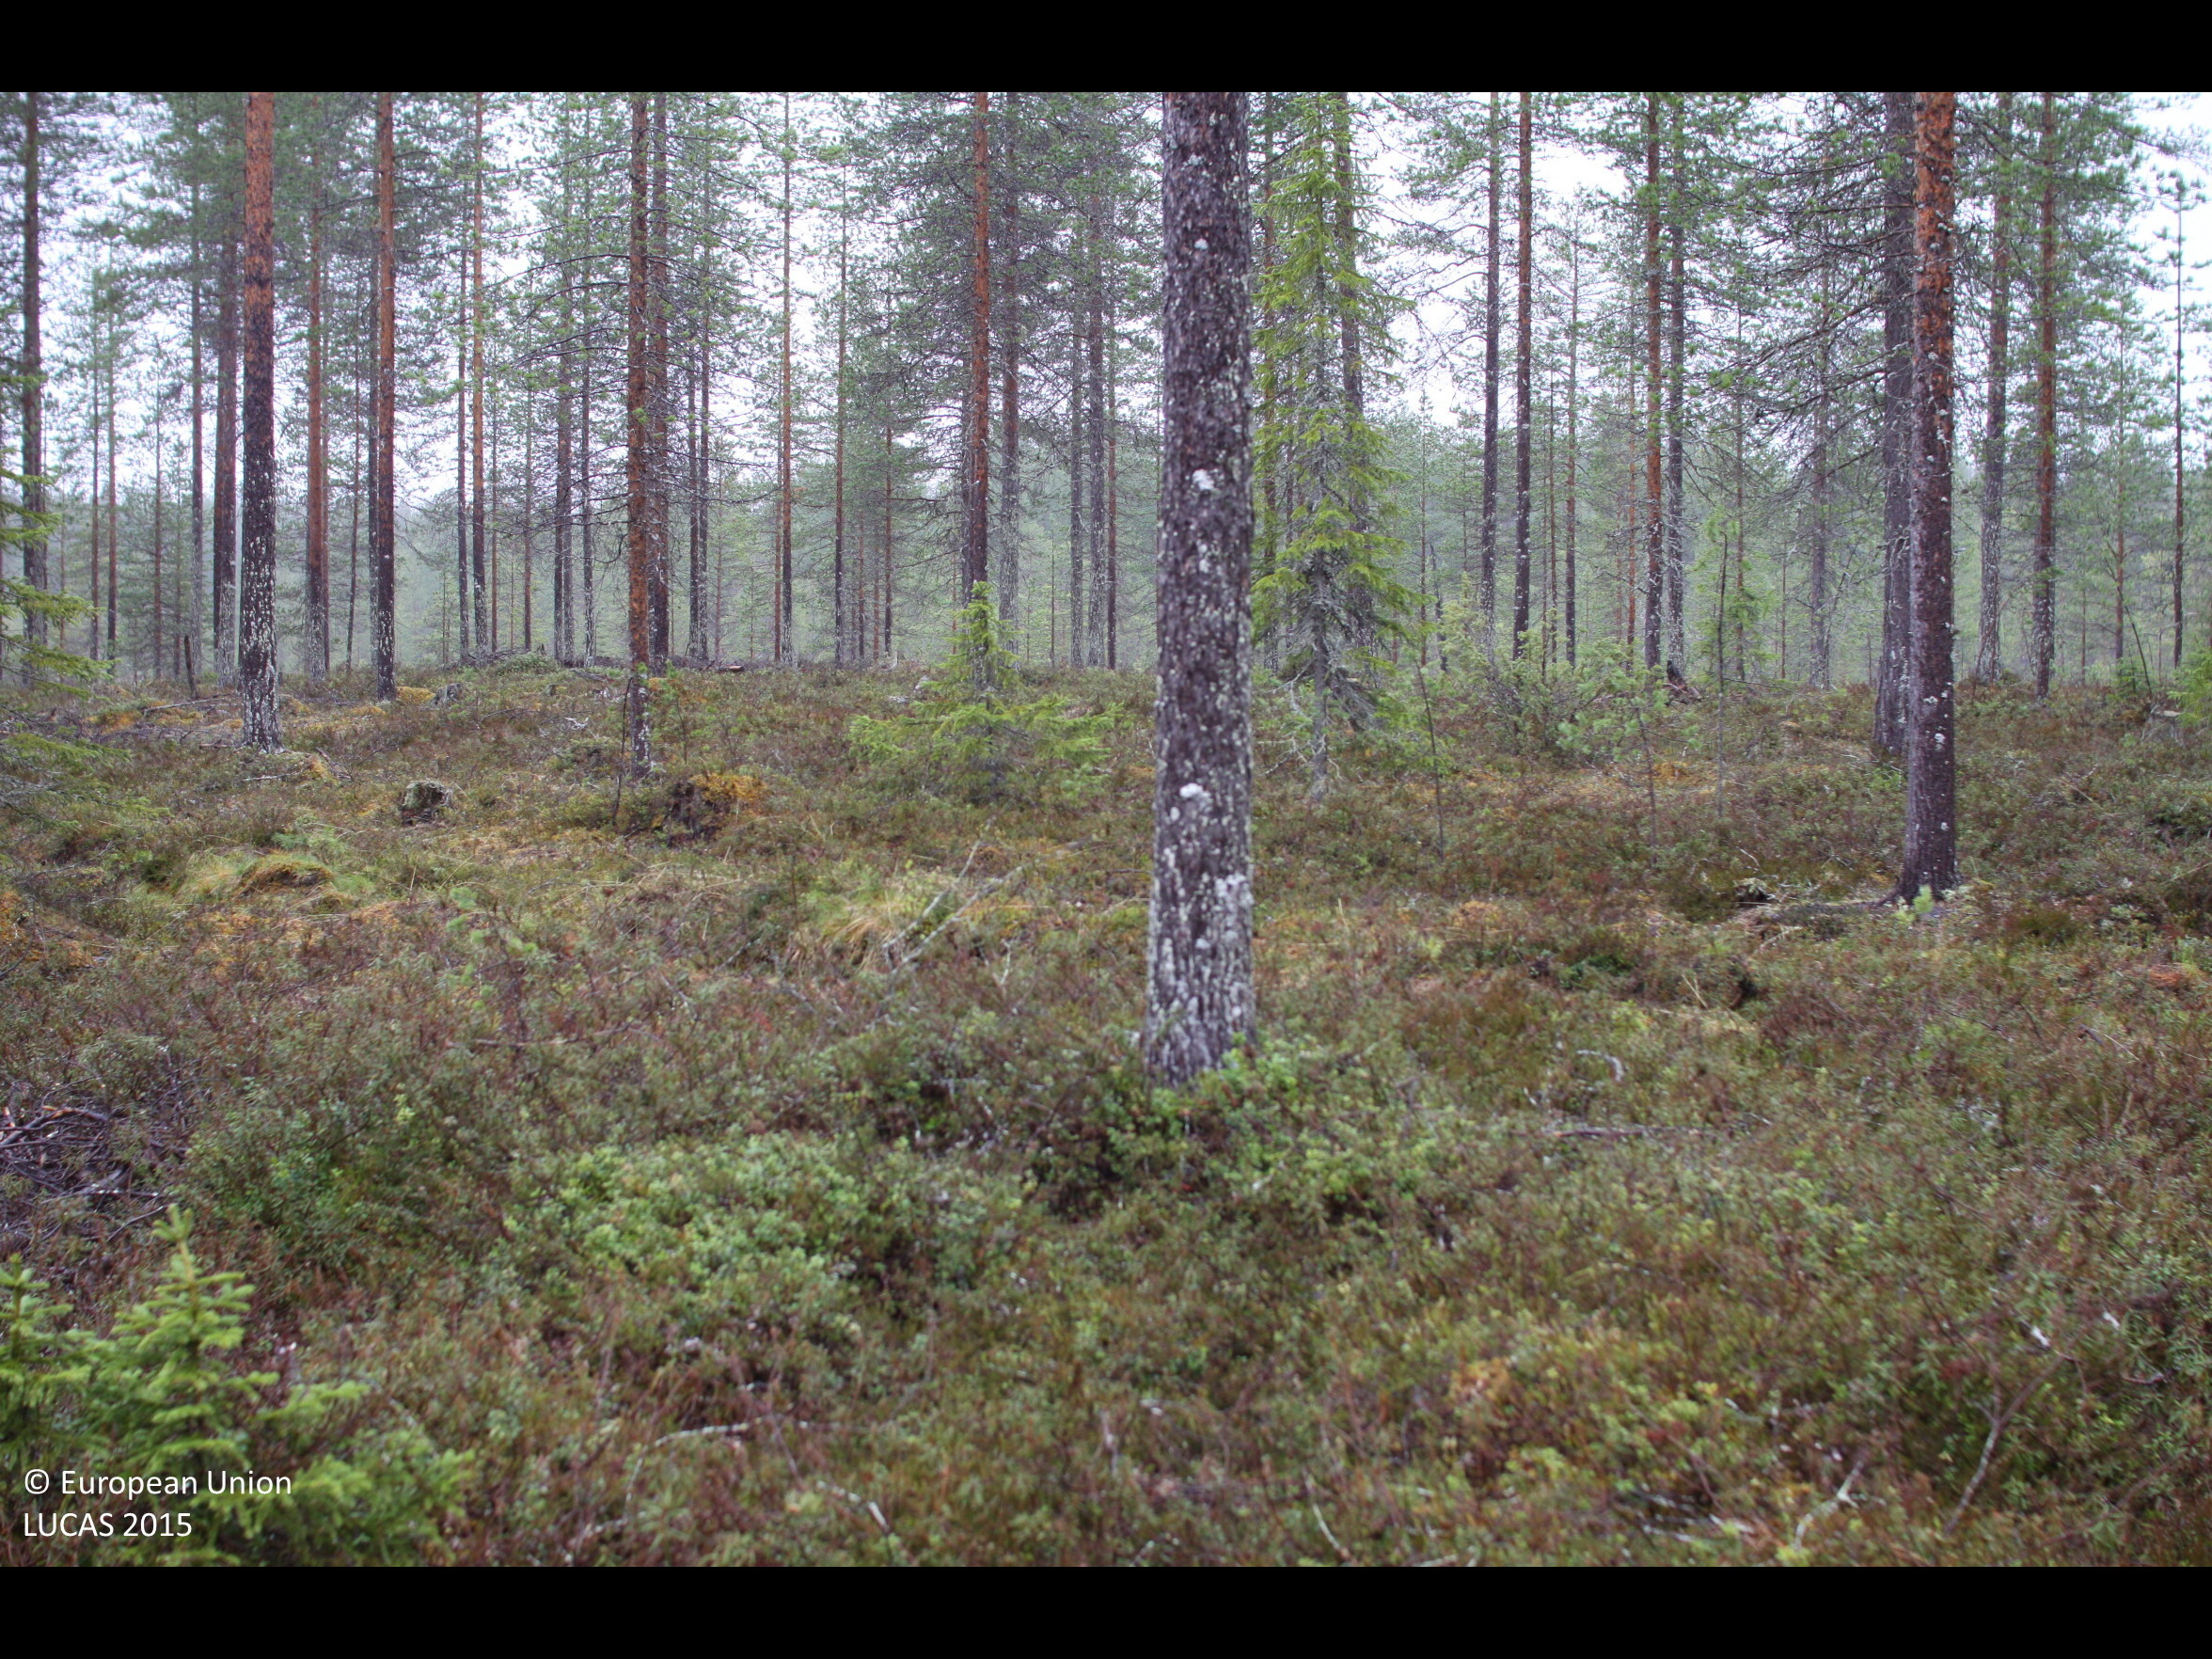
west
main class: Woodland
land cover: Pine dominated coniferous woodland
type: boreal forest
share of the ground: 50 - 75 %
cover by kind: coniferous forest trees 70 %, shrubs 30 %
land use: Forestry
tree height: > 5 m
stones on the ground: < 10 %
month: June
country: FI
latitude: 66.3383
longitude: 27.3277
